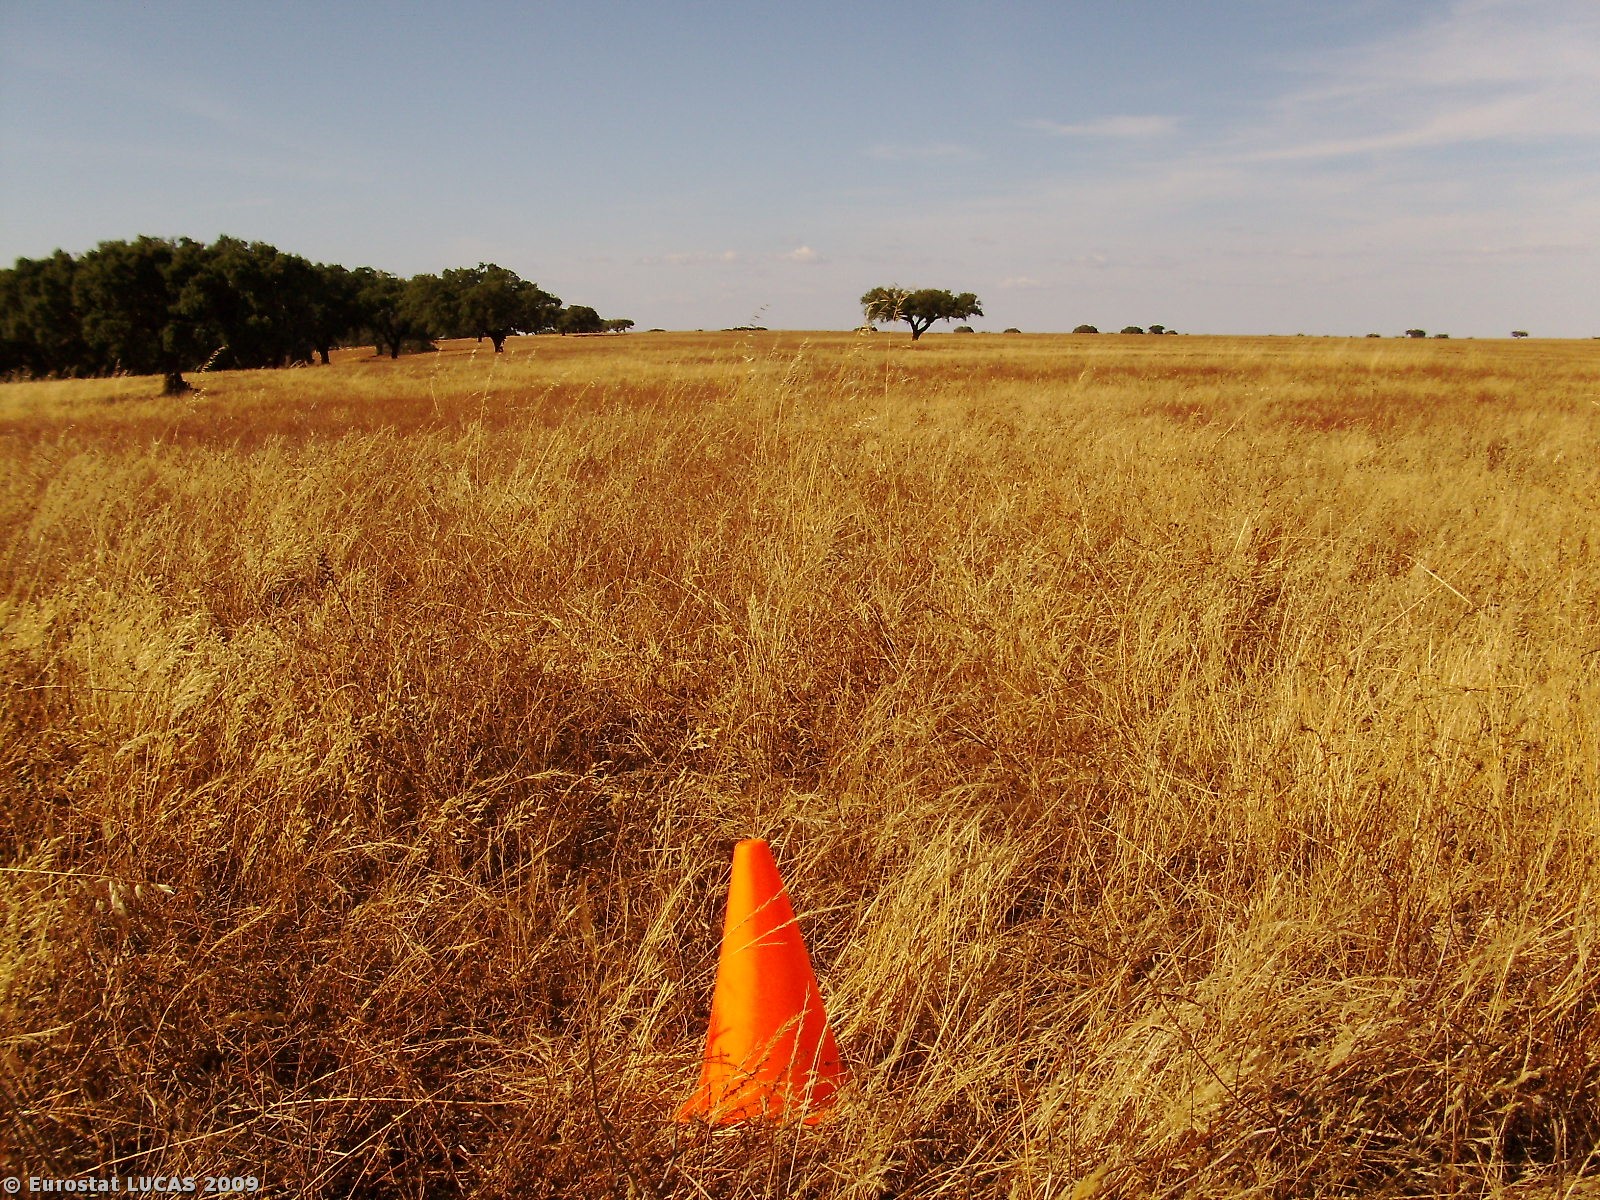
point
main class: Grassland
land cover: Grassland without tree/shrub cover
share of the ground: > 75 %
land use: Agriculture (excluding fallow land and kitchen gardens)
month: June
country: PT
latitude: 37.9991
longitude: -8.3625
